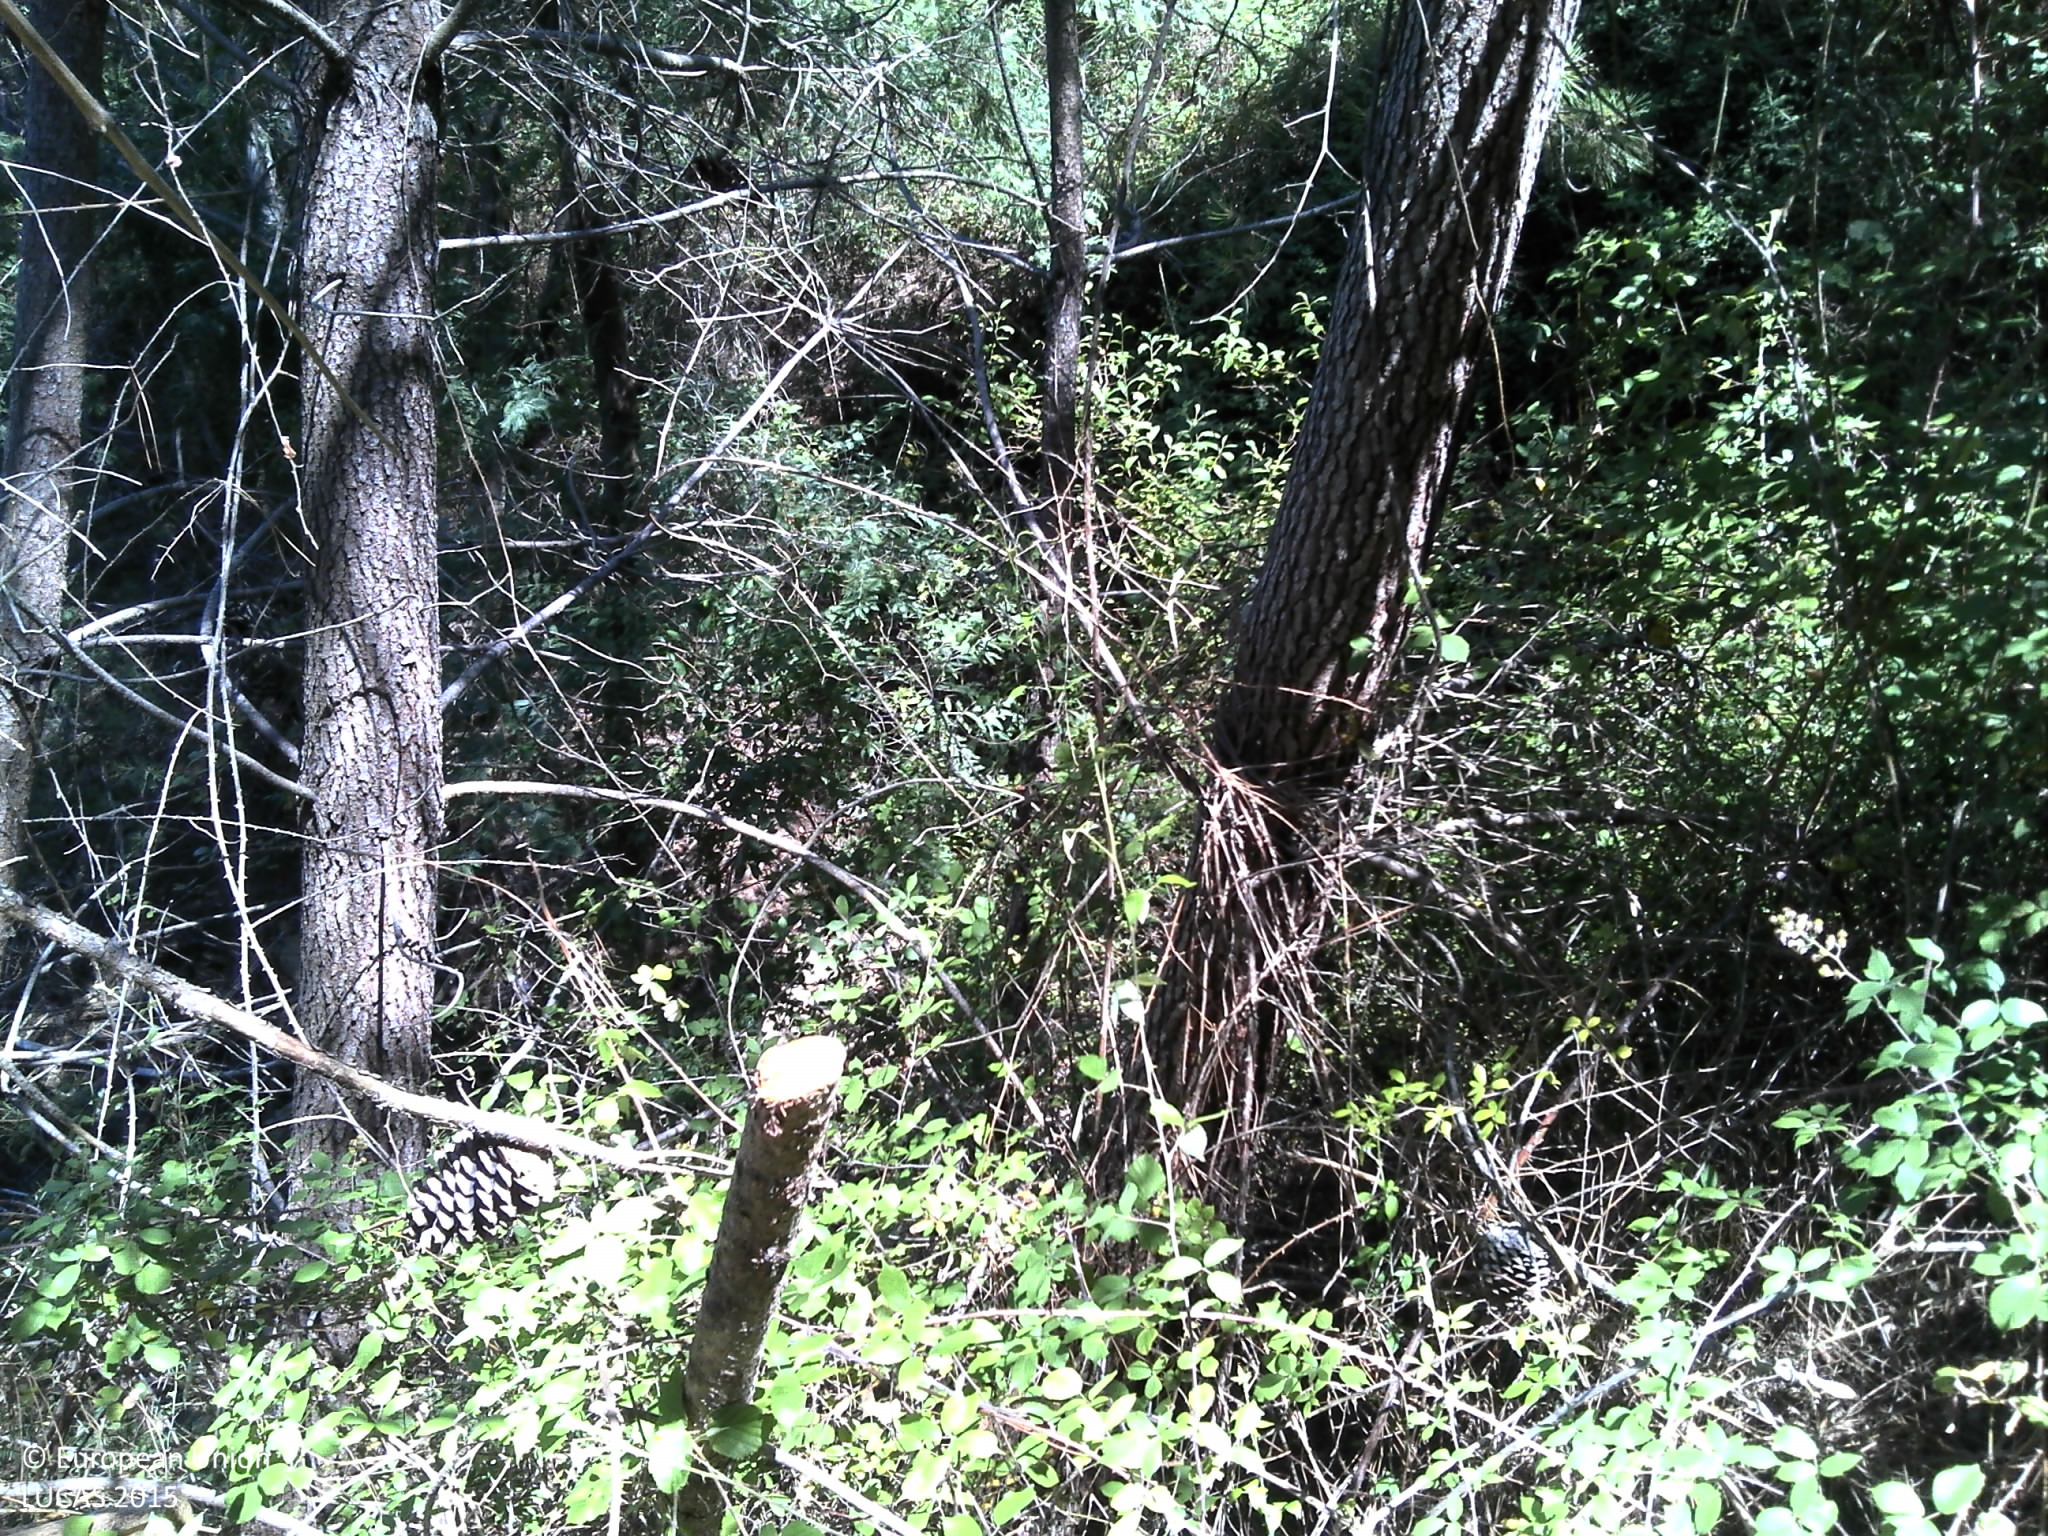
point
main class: Woodland
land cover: Pine dominated coniferous woodland
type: coniferous forest of the mediterranean region
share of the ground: 10 - 25 %
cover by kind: shrubs 80 %, coniferous forest trees 15 %, unconsolidated bare surface 5 %
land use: Forestry
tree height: > 5 m
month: July
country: PT
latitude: 39.9309
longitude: -8.1257
